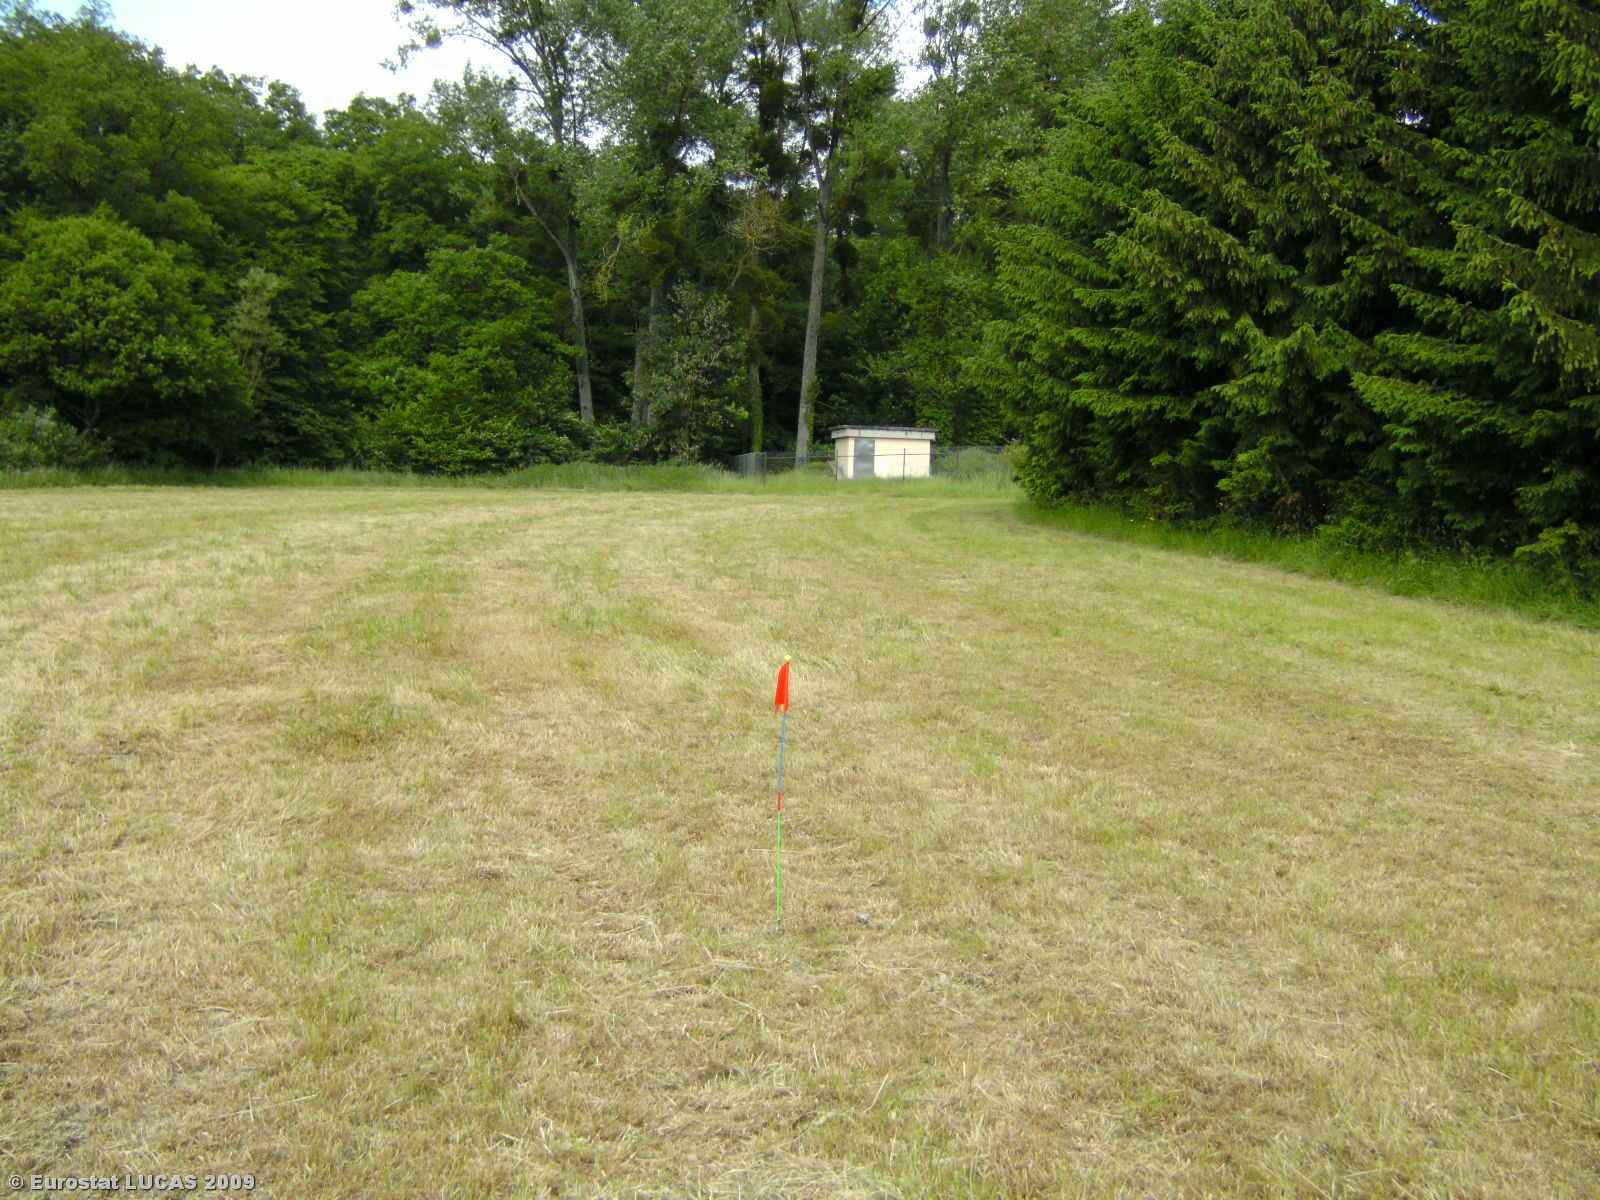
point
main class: Grassland
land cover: Grassland without tree/shrub cover
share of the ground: > 75 %
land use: Agriculture (excluding fallow land and kitchen gardens)
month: June
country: LU
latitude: 49.5987
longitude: 6.1946
